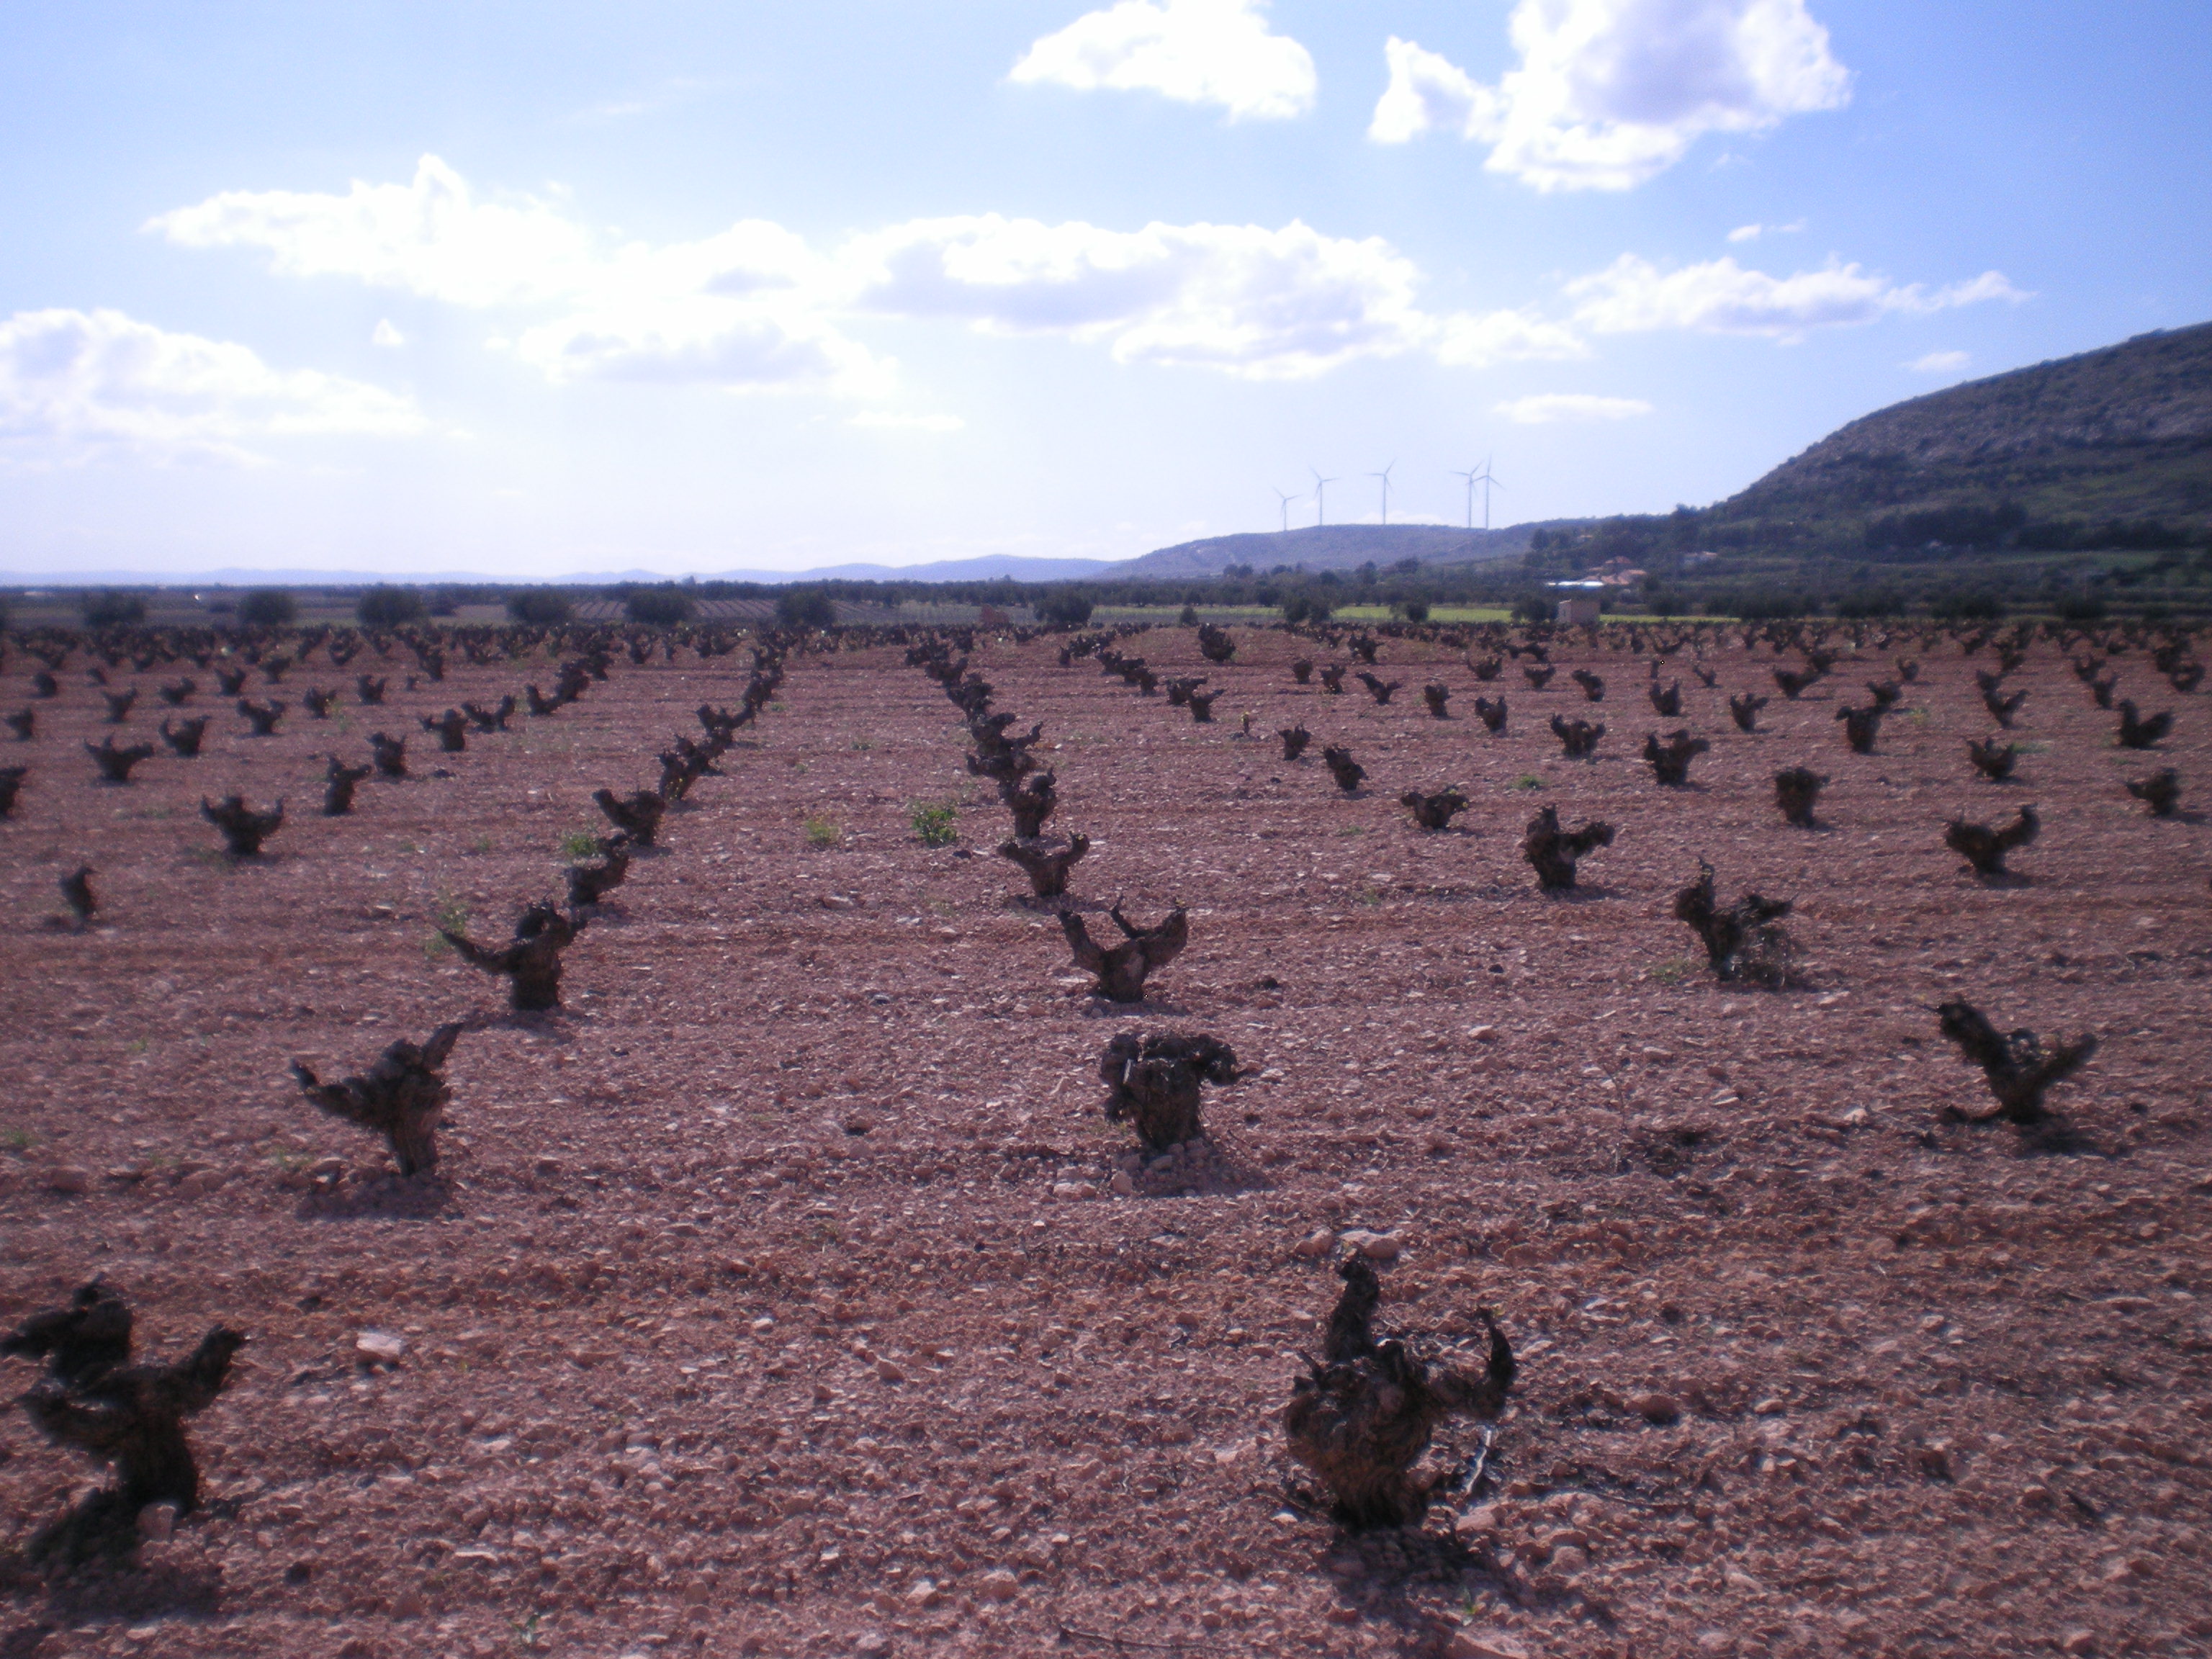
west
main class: Cropland
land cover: Vineyards
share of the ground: < 10 %
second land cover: Other bare soil
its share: > 75 %
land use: Agriculture (excluding fallow land and kitchen gardens)
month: April
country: ES
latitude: 38.8215
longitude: -3.5936
